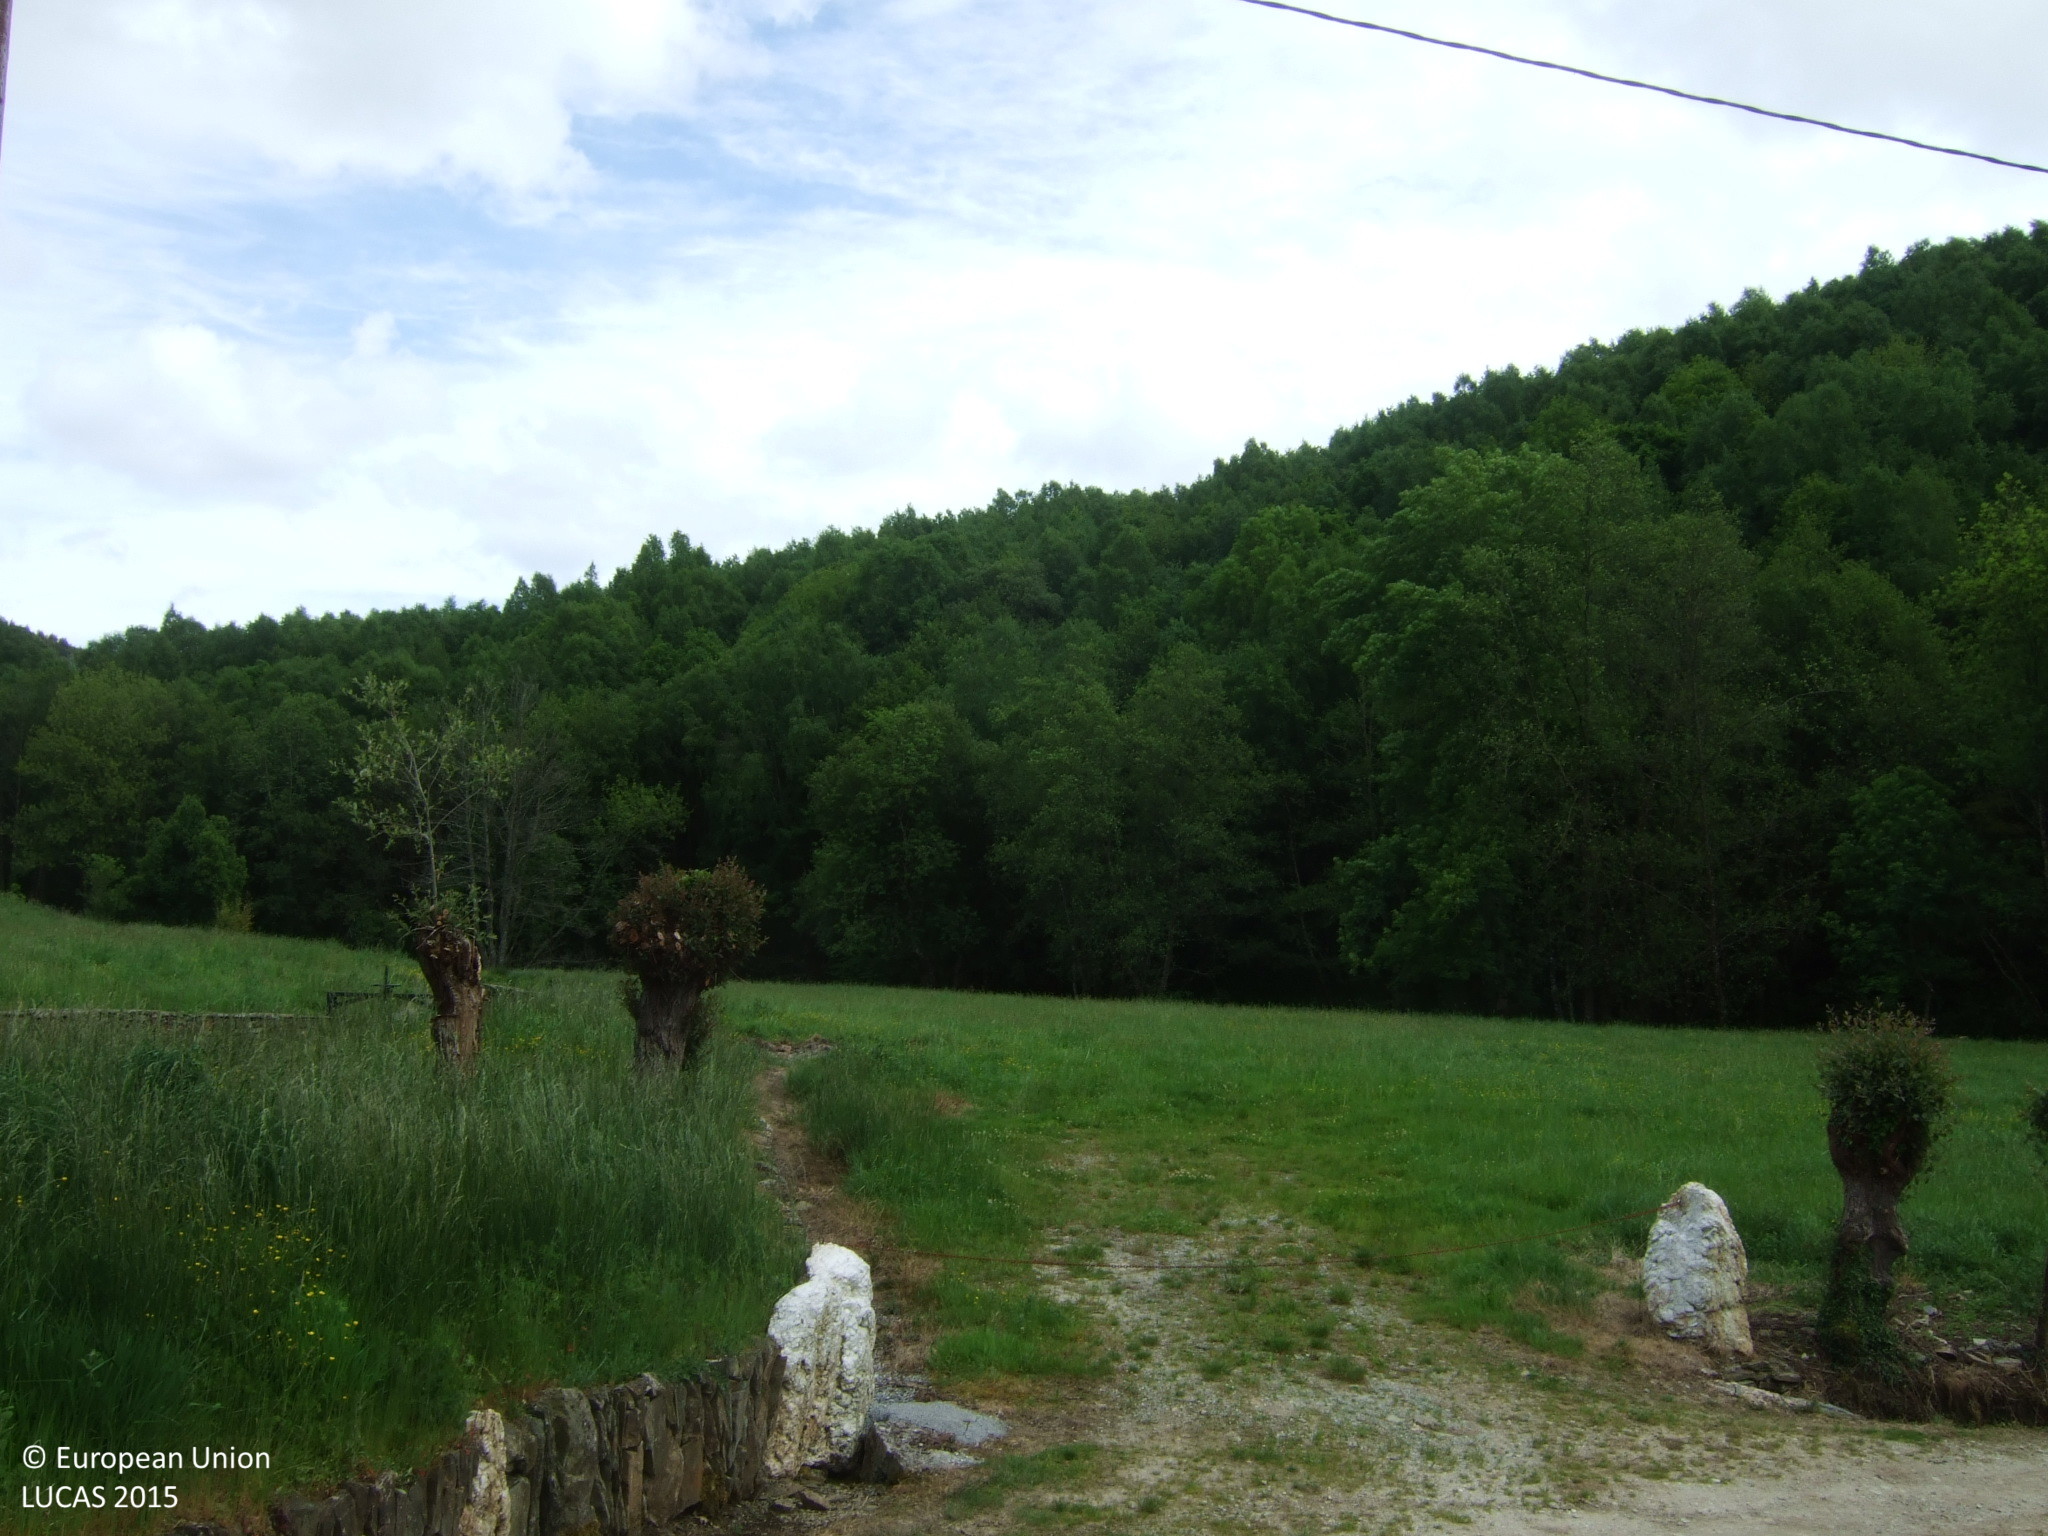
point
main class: Woodland
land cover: Broadleaved woodland
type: acidophilous oak and oak-birch forest
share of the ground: 50 - 75 %
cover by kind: broadleaved forest trees 70 %, unconsolidated bare surface 20 %, shrubs 10 %
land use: Forestry
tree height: > 5 m
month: May
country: ES
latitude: 43.1823
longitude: -7.3851
